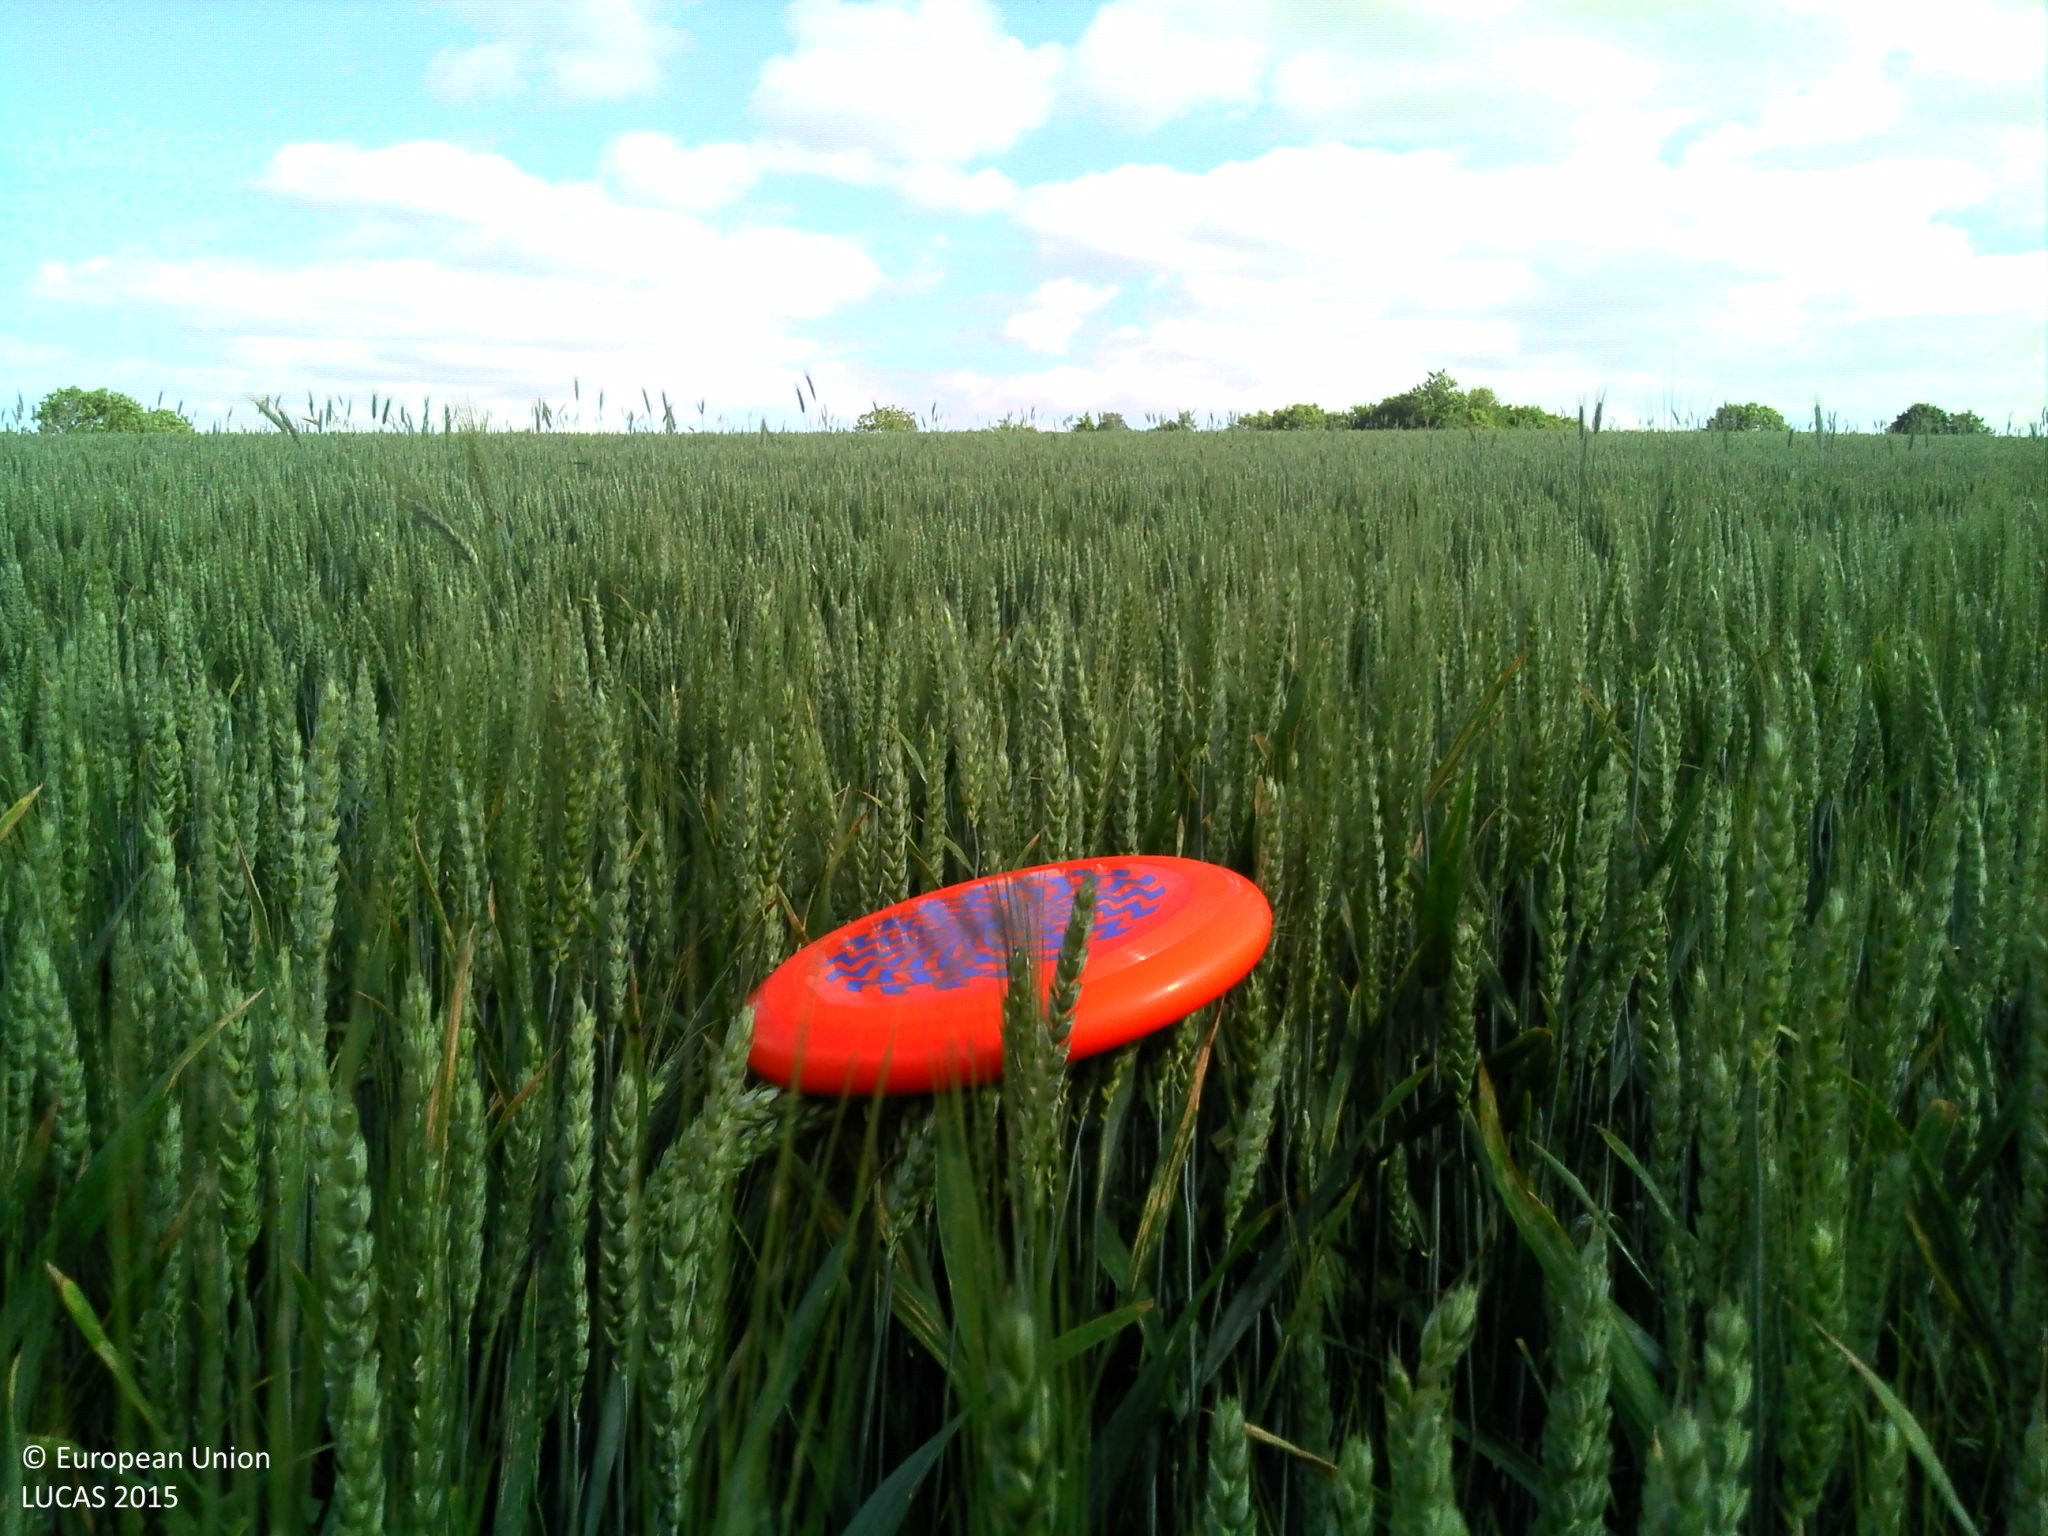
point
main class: Cropland
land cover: Common wheat
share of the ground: > 75 %
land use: Agriculture (excluding fallow land and kitchen gardens)
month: June
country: FR
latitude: 48.4626
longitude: -0.1331
